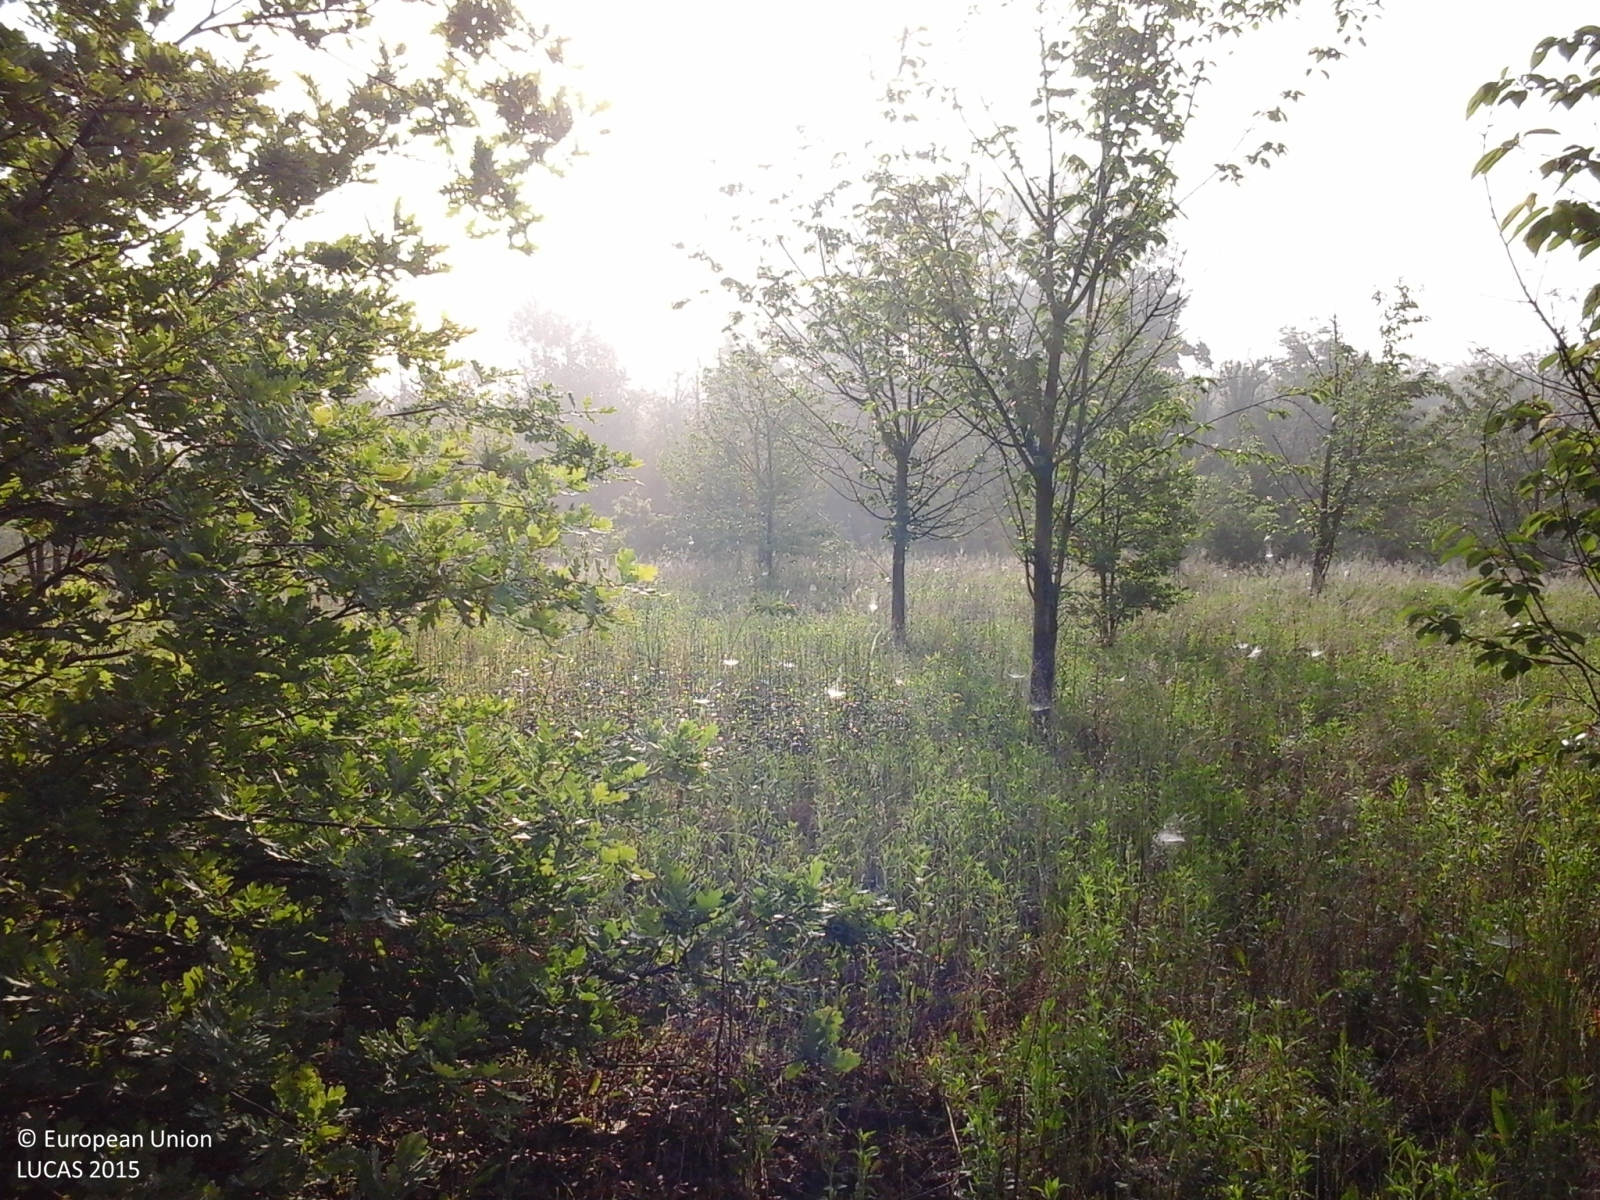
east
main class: Cropland
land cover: Cherry fruit
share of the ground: 10 - 25 %
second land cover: Spontaneously vegetated surfaces
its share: > 75 %
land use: Abandoned areas
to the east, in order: Cherry fruit; Spontaneously vegetated surfaces; Broadleaved woodland; Ditches and canals; Broadleaved woodland; Shruby margins; Broadleaved woodland
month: May
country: IT
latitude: 44.9341
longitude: 8.4444
